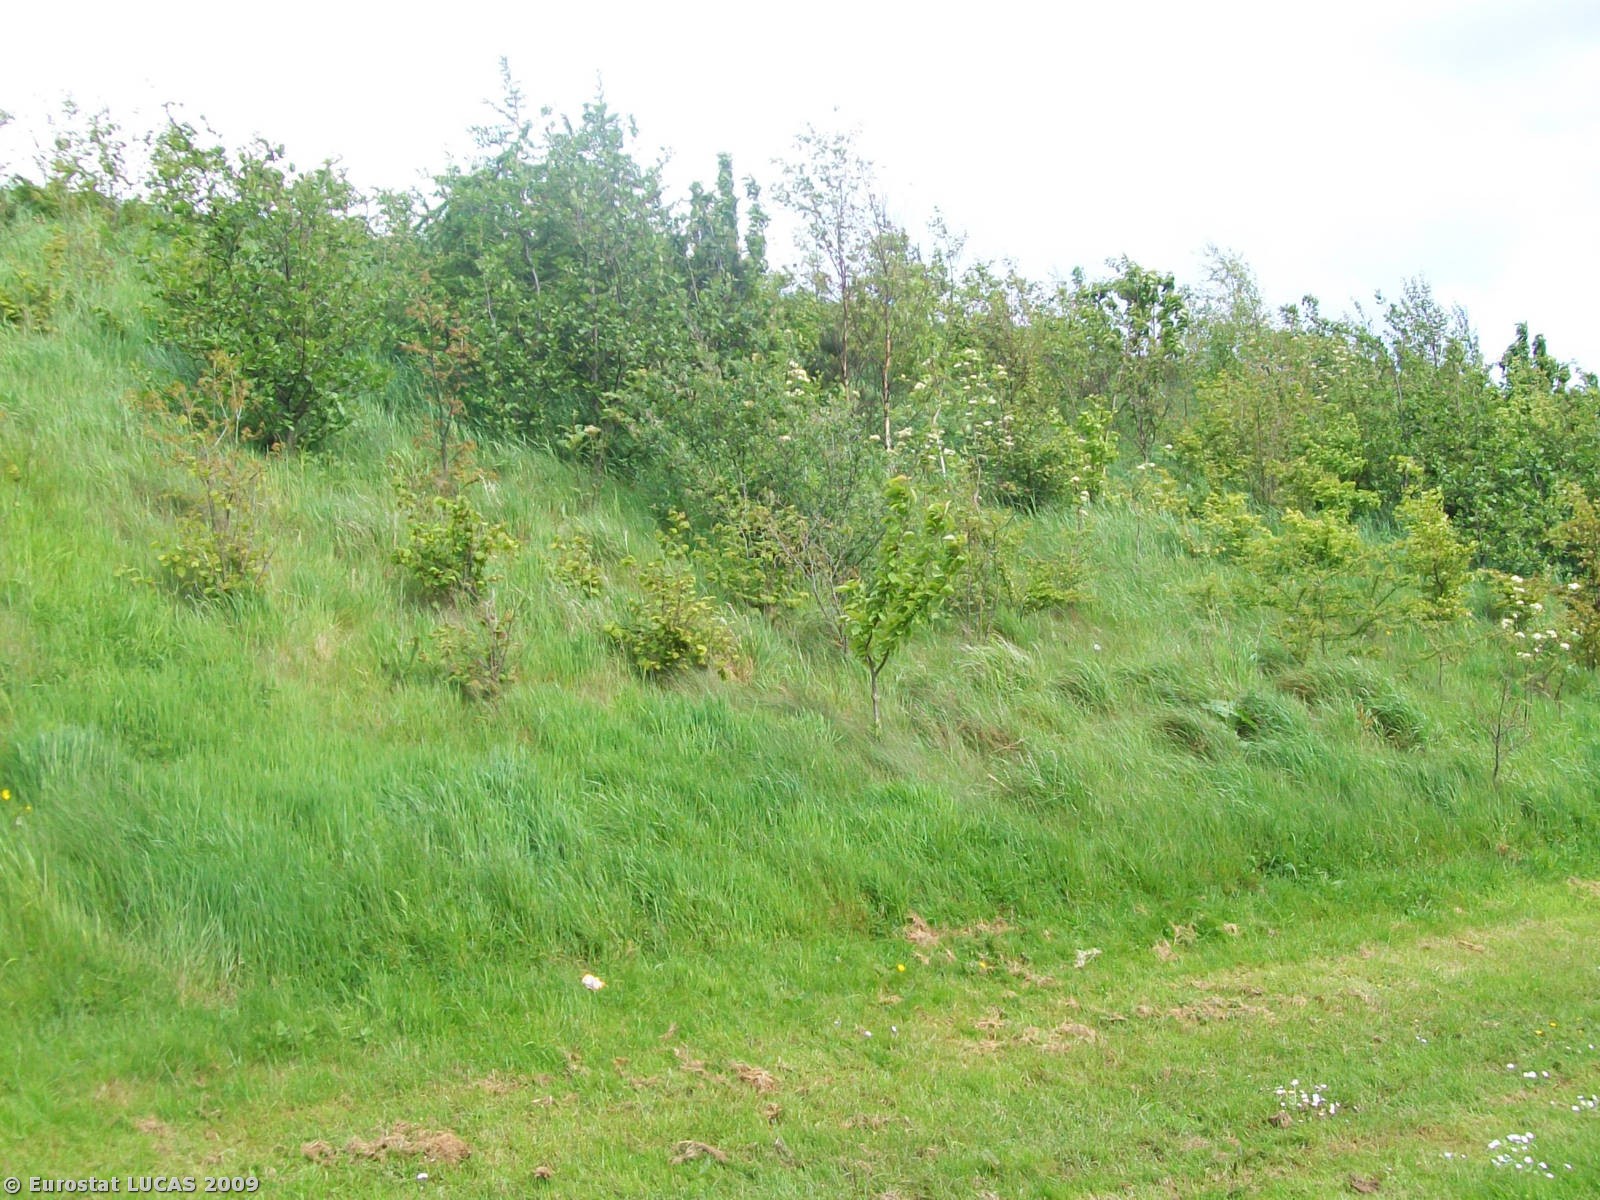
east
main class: Grassland
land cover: Grassland without tree/shrub cover
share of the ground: > 75 %
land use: Sport
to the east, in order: Grassland without tree/shrub cover; Broadleaved woodland; Grassland without tree/shrub cover; Fences; Grassland without tree/shrub cover; Fences; Abandoned hedges; Grass margins; Bare land; Grass margins; Managed hedges
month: May
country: GB
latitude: 54.5785
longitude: -5.7758
